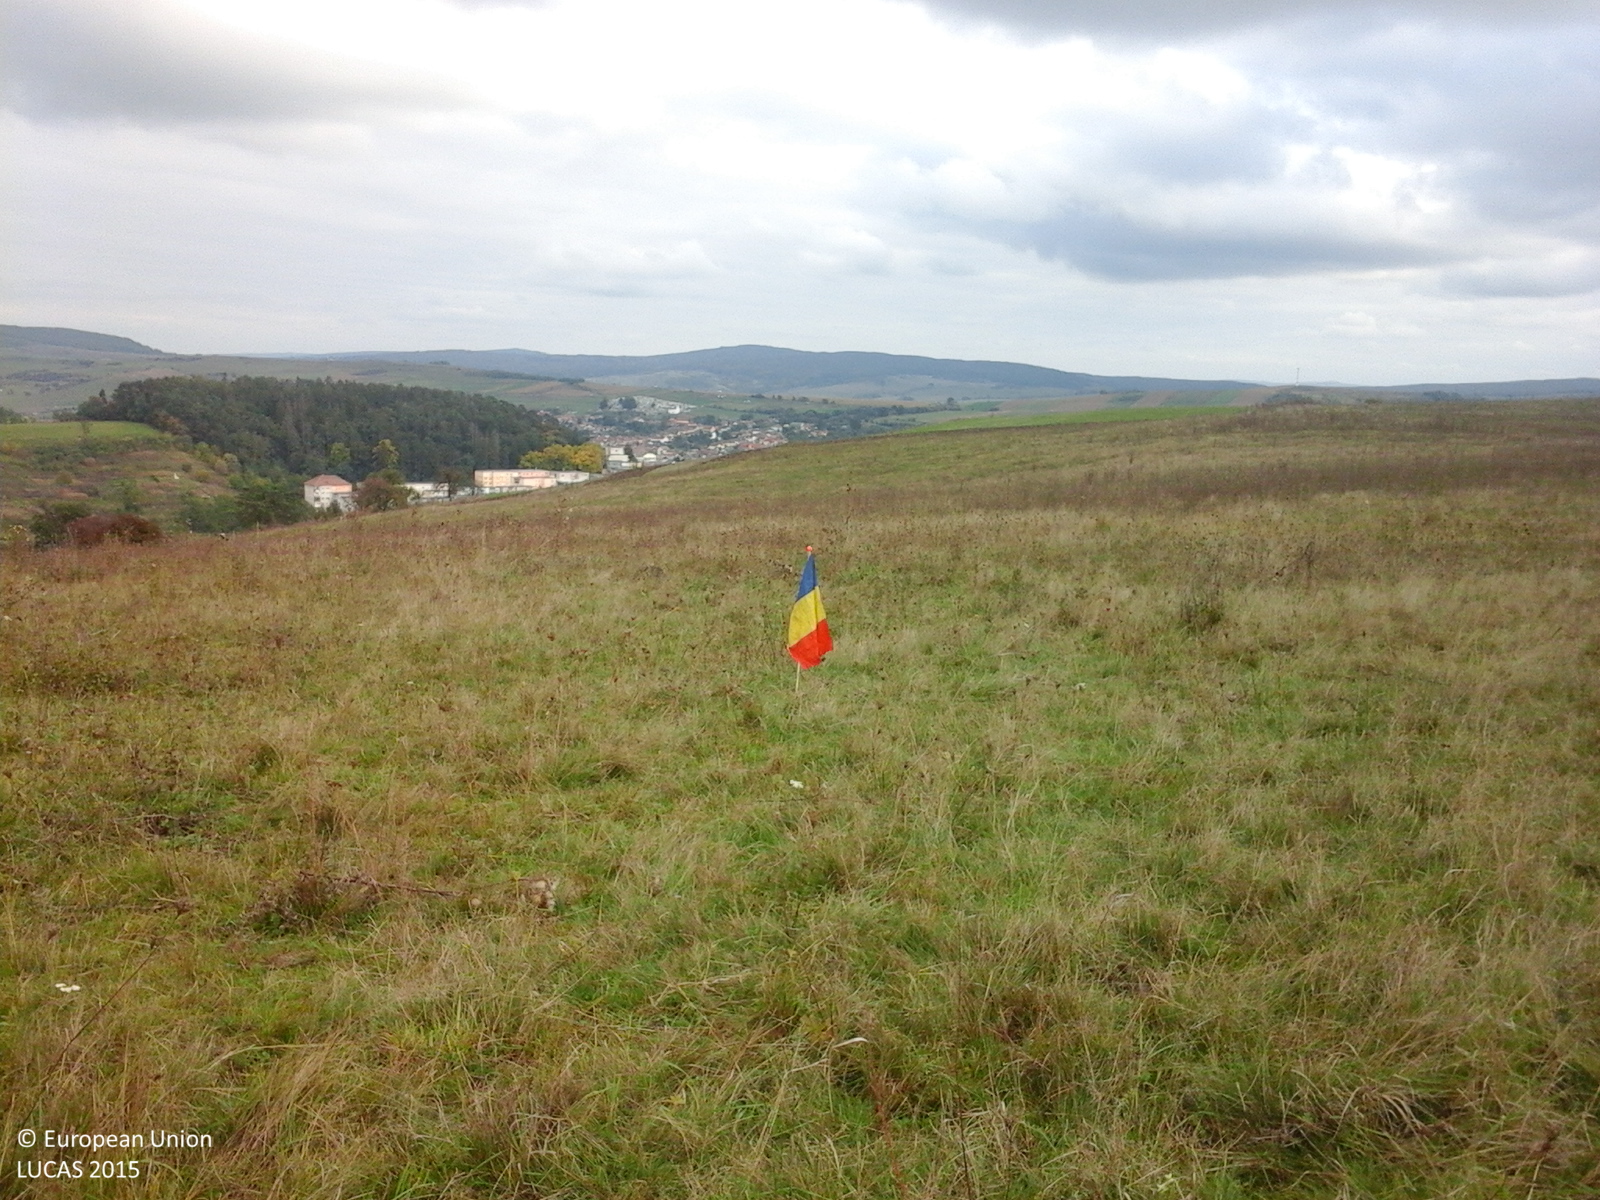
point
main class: Grassland
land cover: Grassland without tree/shrub cover
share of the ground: > 75 %
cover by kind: herbaceous plants 100 %
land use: Agriculture (excluding fallow land and kitchen gardens)
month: October
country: RO
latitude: 45.9820
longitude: 24.6071
